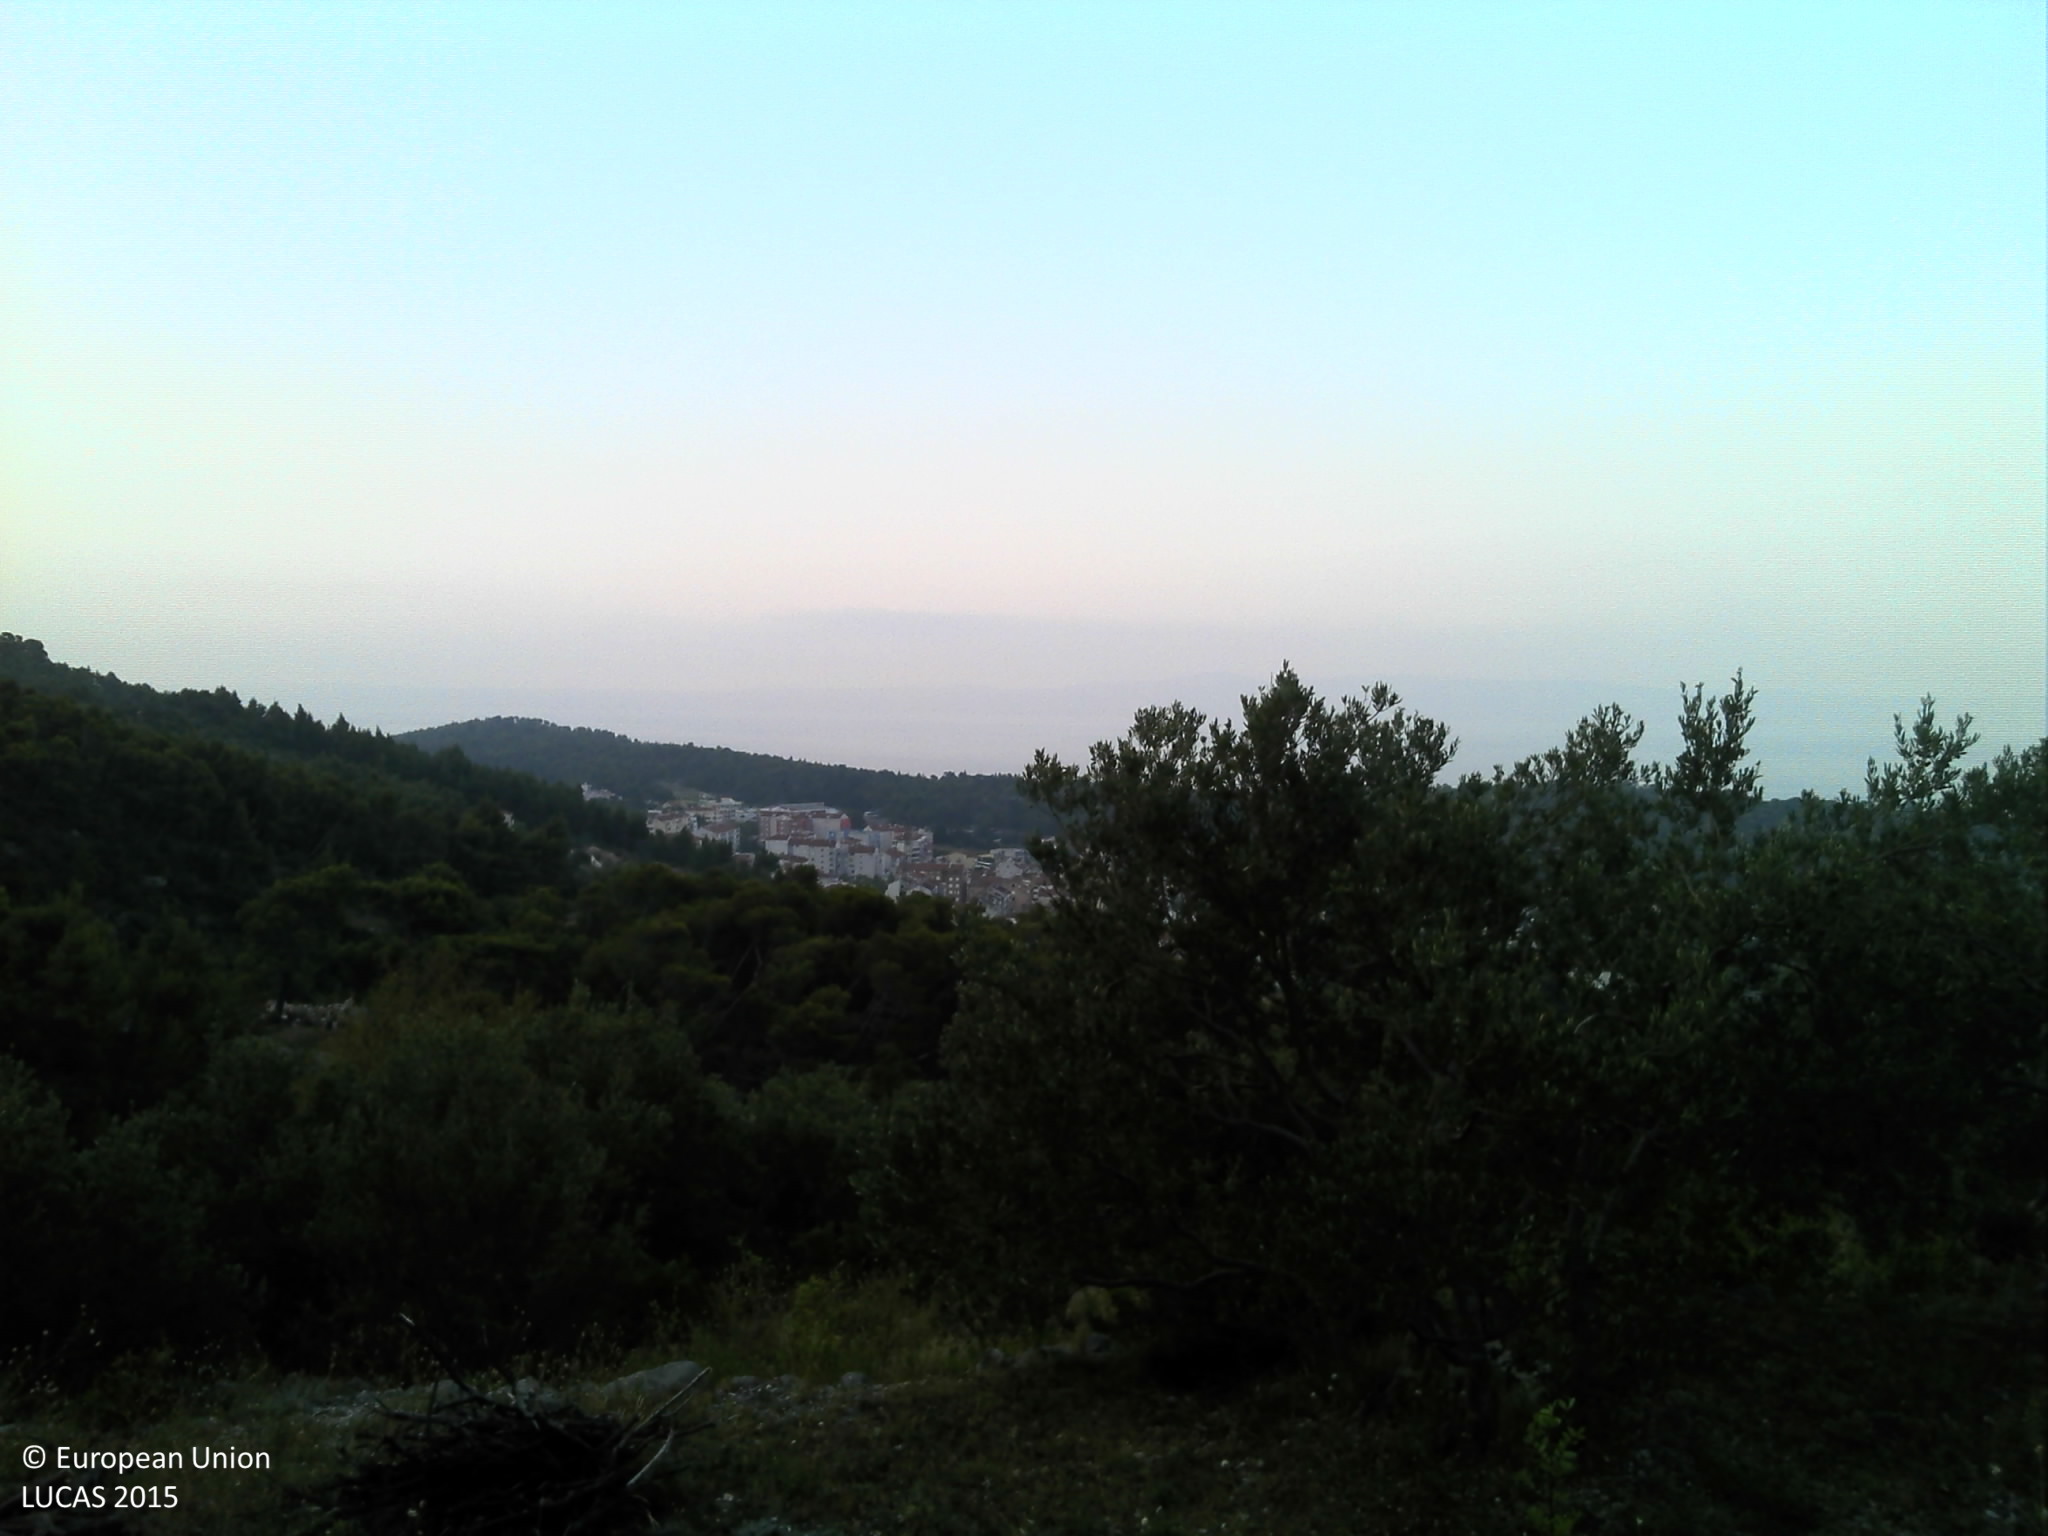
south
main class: Cropland
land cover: Olive groves
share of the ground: > 75 %
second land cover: Grassland without tree/shrub cover
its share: > 75 %
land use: Agriculture (excluding fallow land and kitchen gardens)
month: August
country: HR
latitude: 43.2973
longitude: 17.0292
